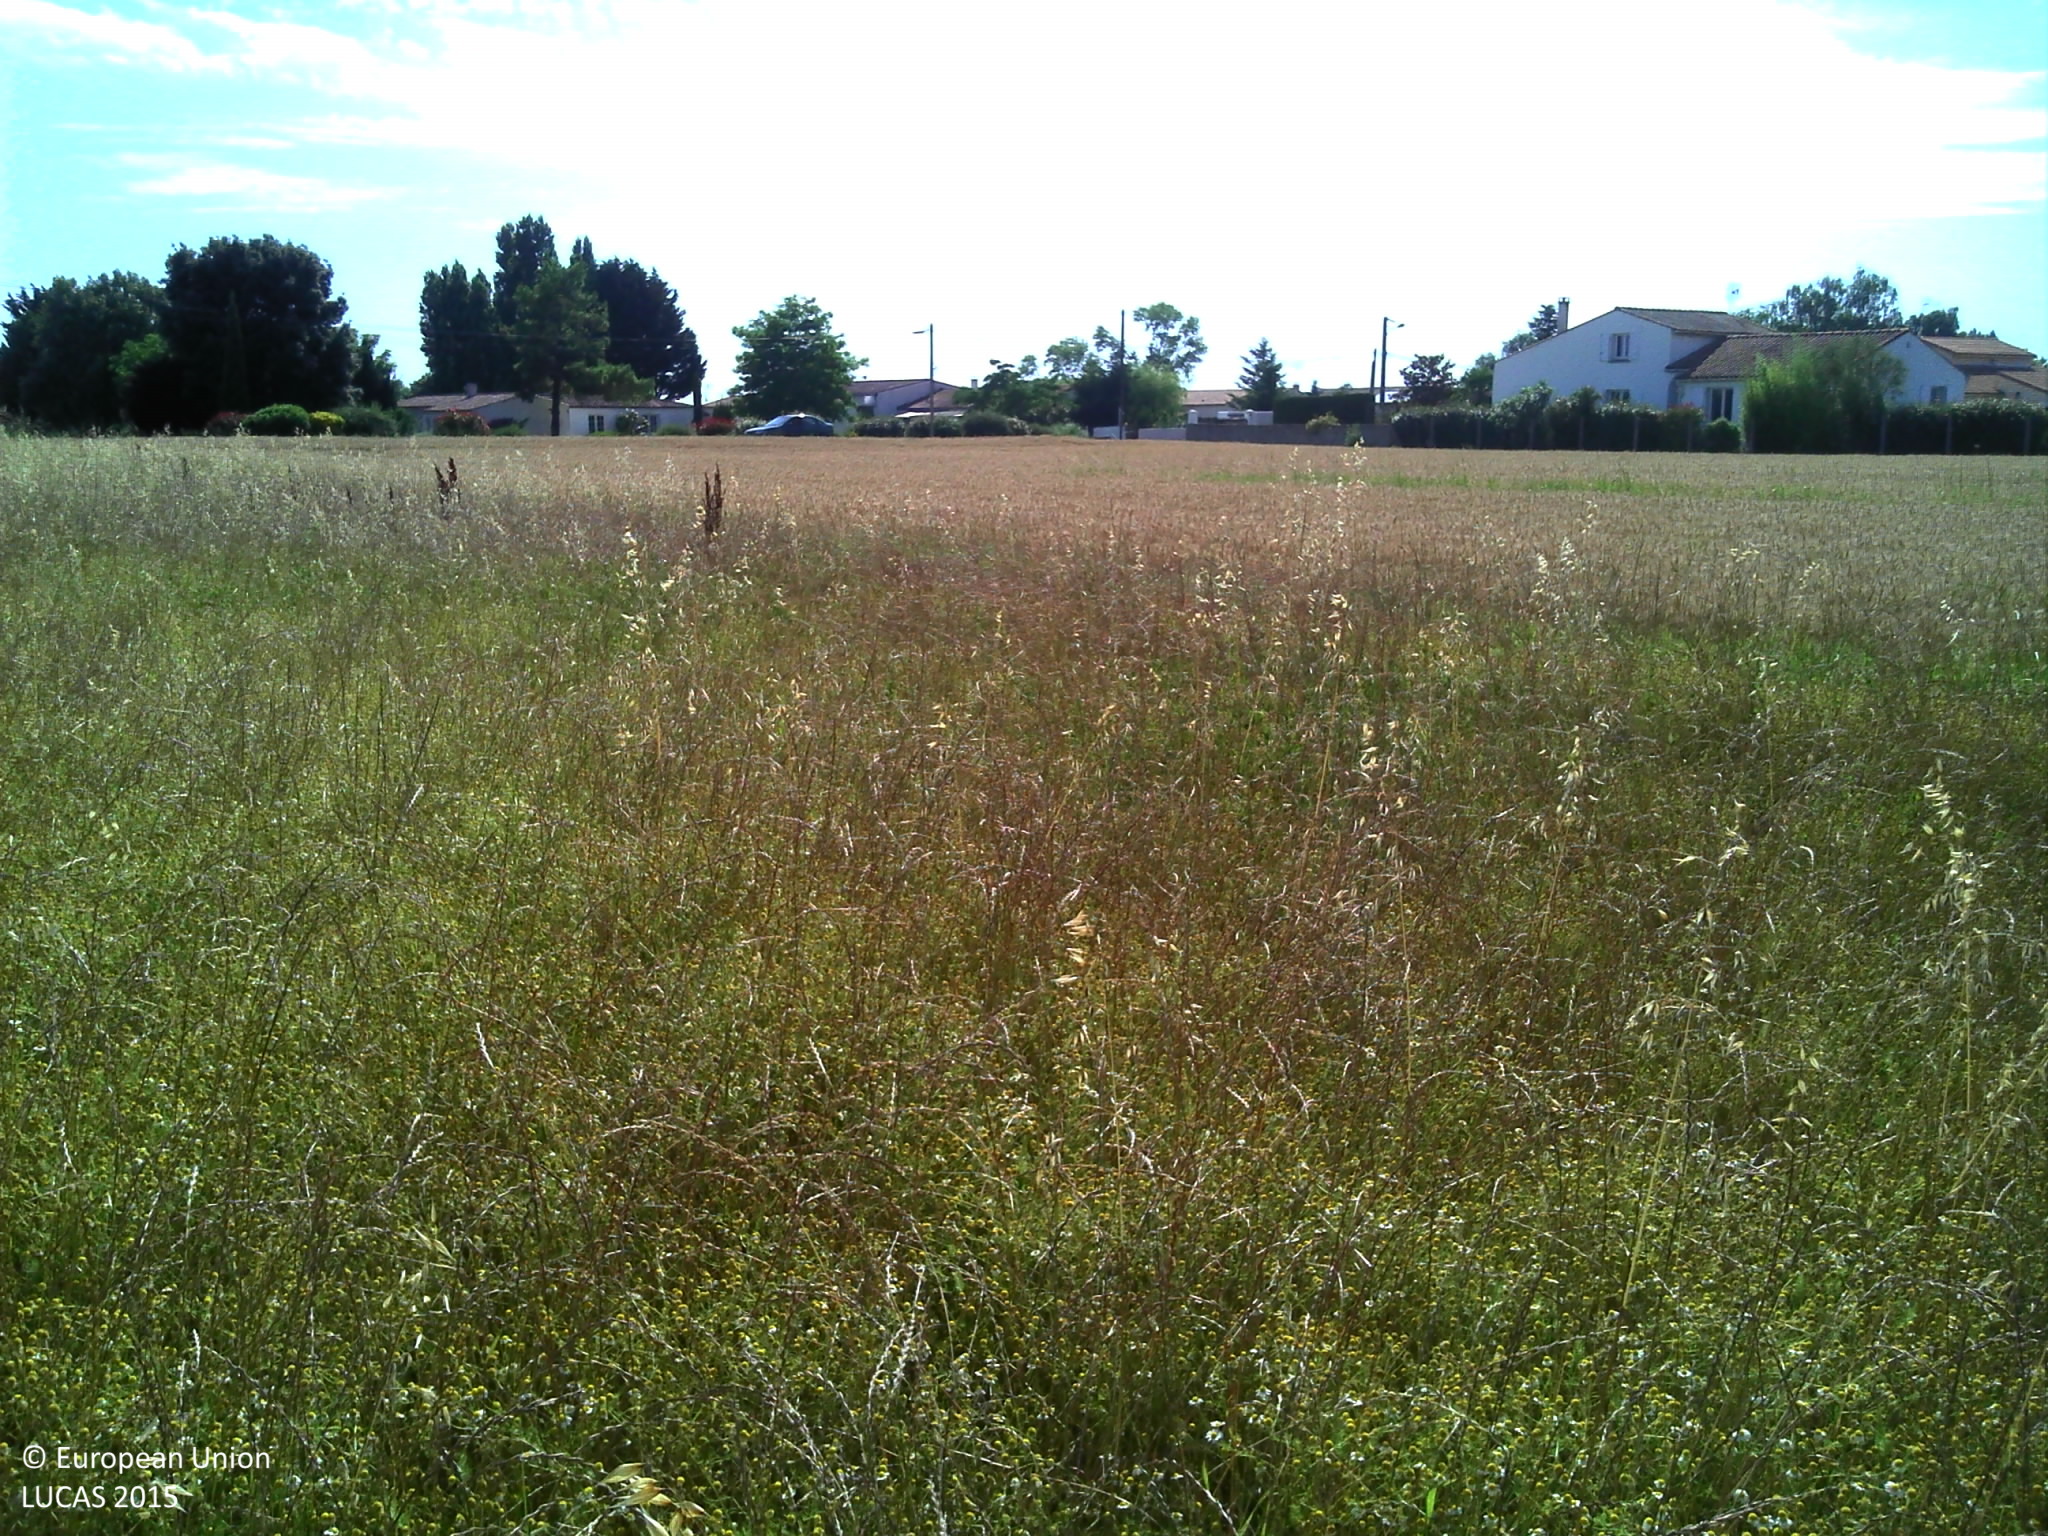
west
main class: Grassland
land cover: Grassland without tree/shrub cover
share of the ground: > 75 %
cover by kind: herbaceous plants 100 %
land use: Agriculture (excluding fallow land and kitchen gardens)
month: June
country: FR
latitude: 45.7314
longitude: -0.9632
